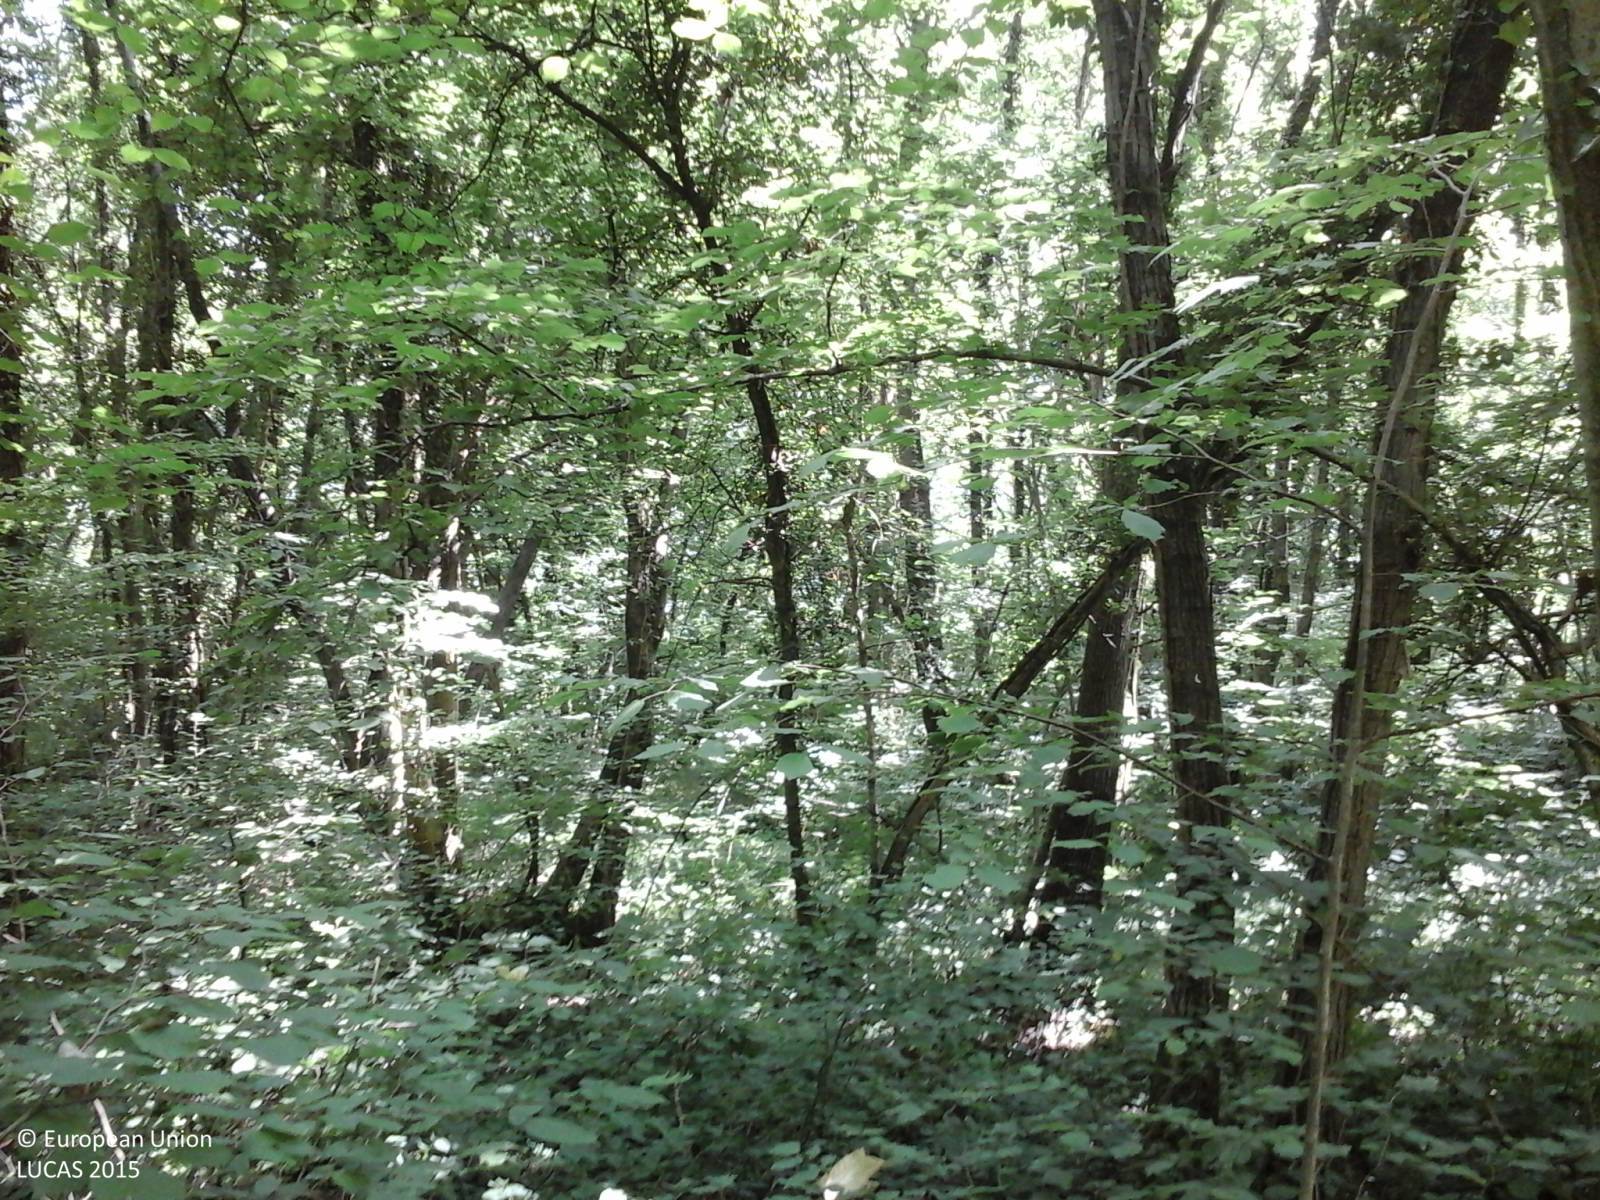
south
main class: Woodland
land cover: Broadleaved woodland
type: mesophytic deciduous forest
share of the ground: > 75 %
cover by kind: broadleaved forest trees 80 %, coniferous forest trees 10 %, shrubs 10 %
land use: Forestry
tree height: > 5 m
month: June
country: IT
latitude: 46.1299
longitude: 13.5557
